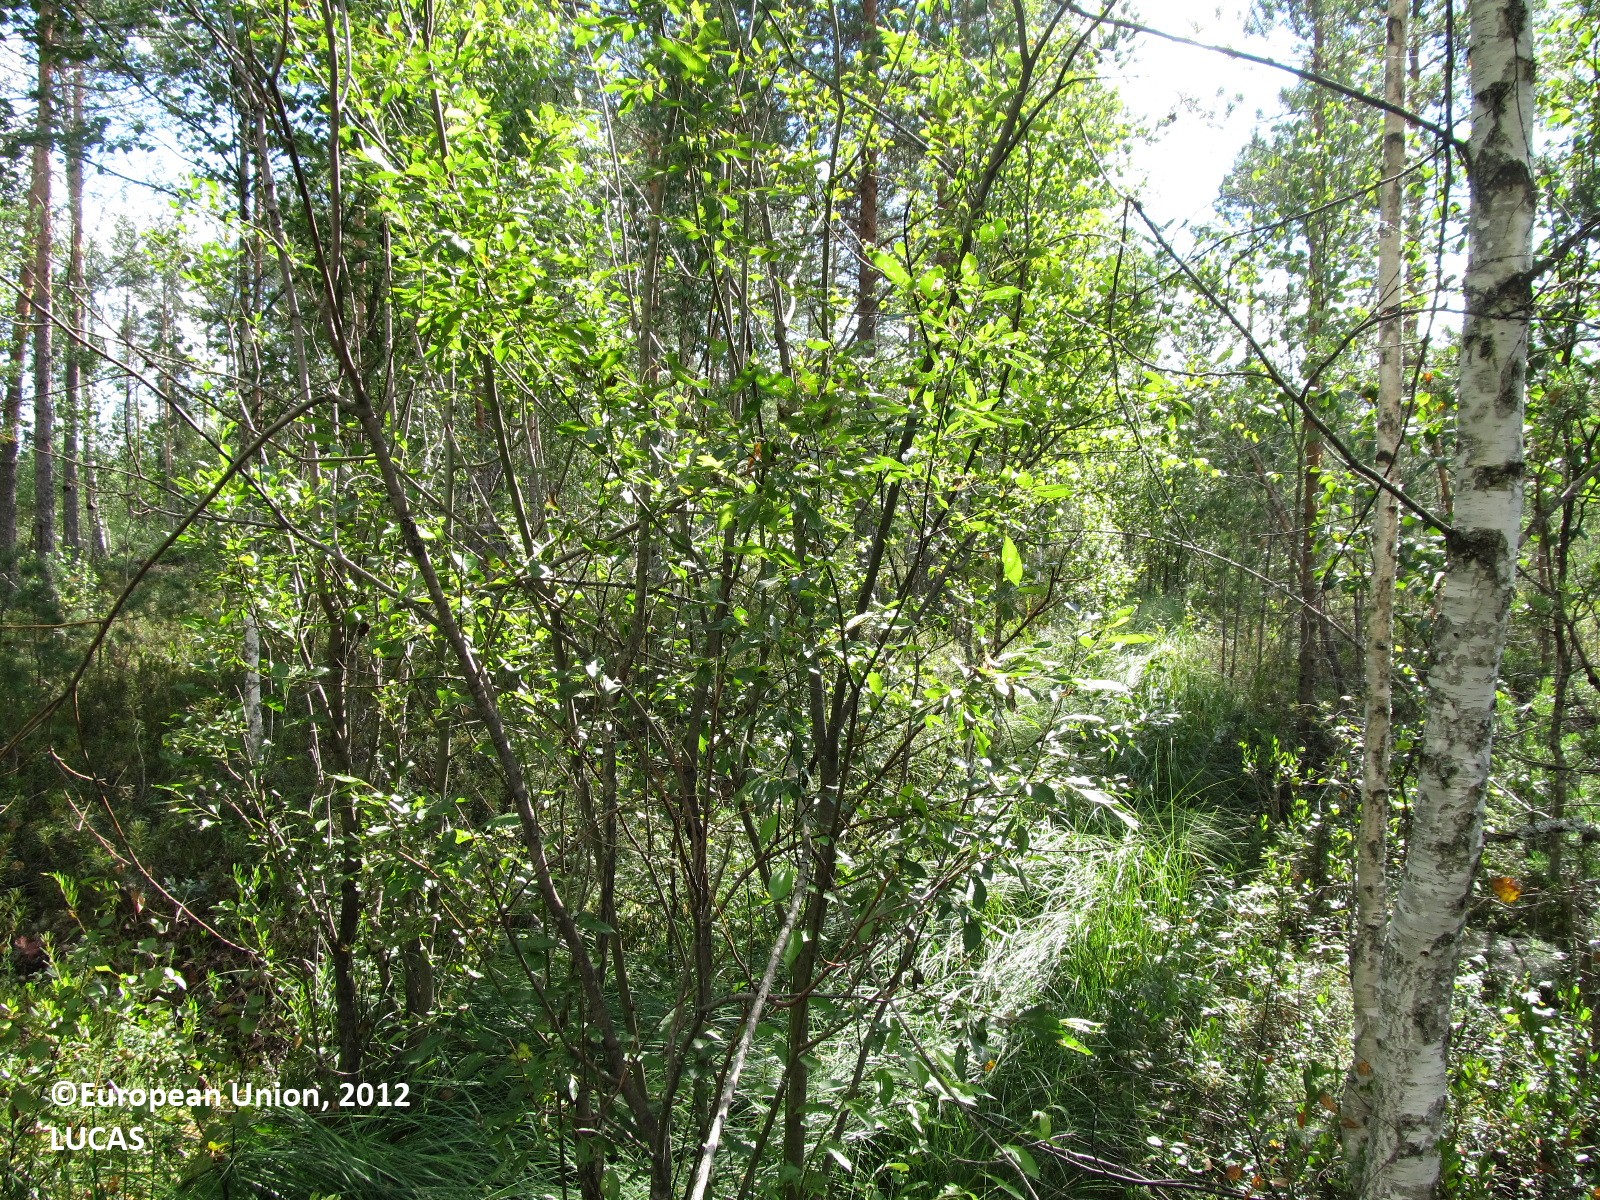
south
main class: Woodland
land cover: Pine dominated coniferous woodland
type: boreal forest
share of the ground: 25 - 50 %
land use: Forestry
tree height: > 5 m
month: August
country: FI
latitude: 62.1712
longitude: 27.6292
